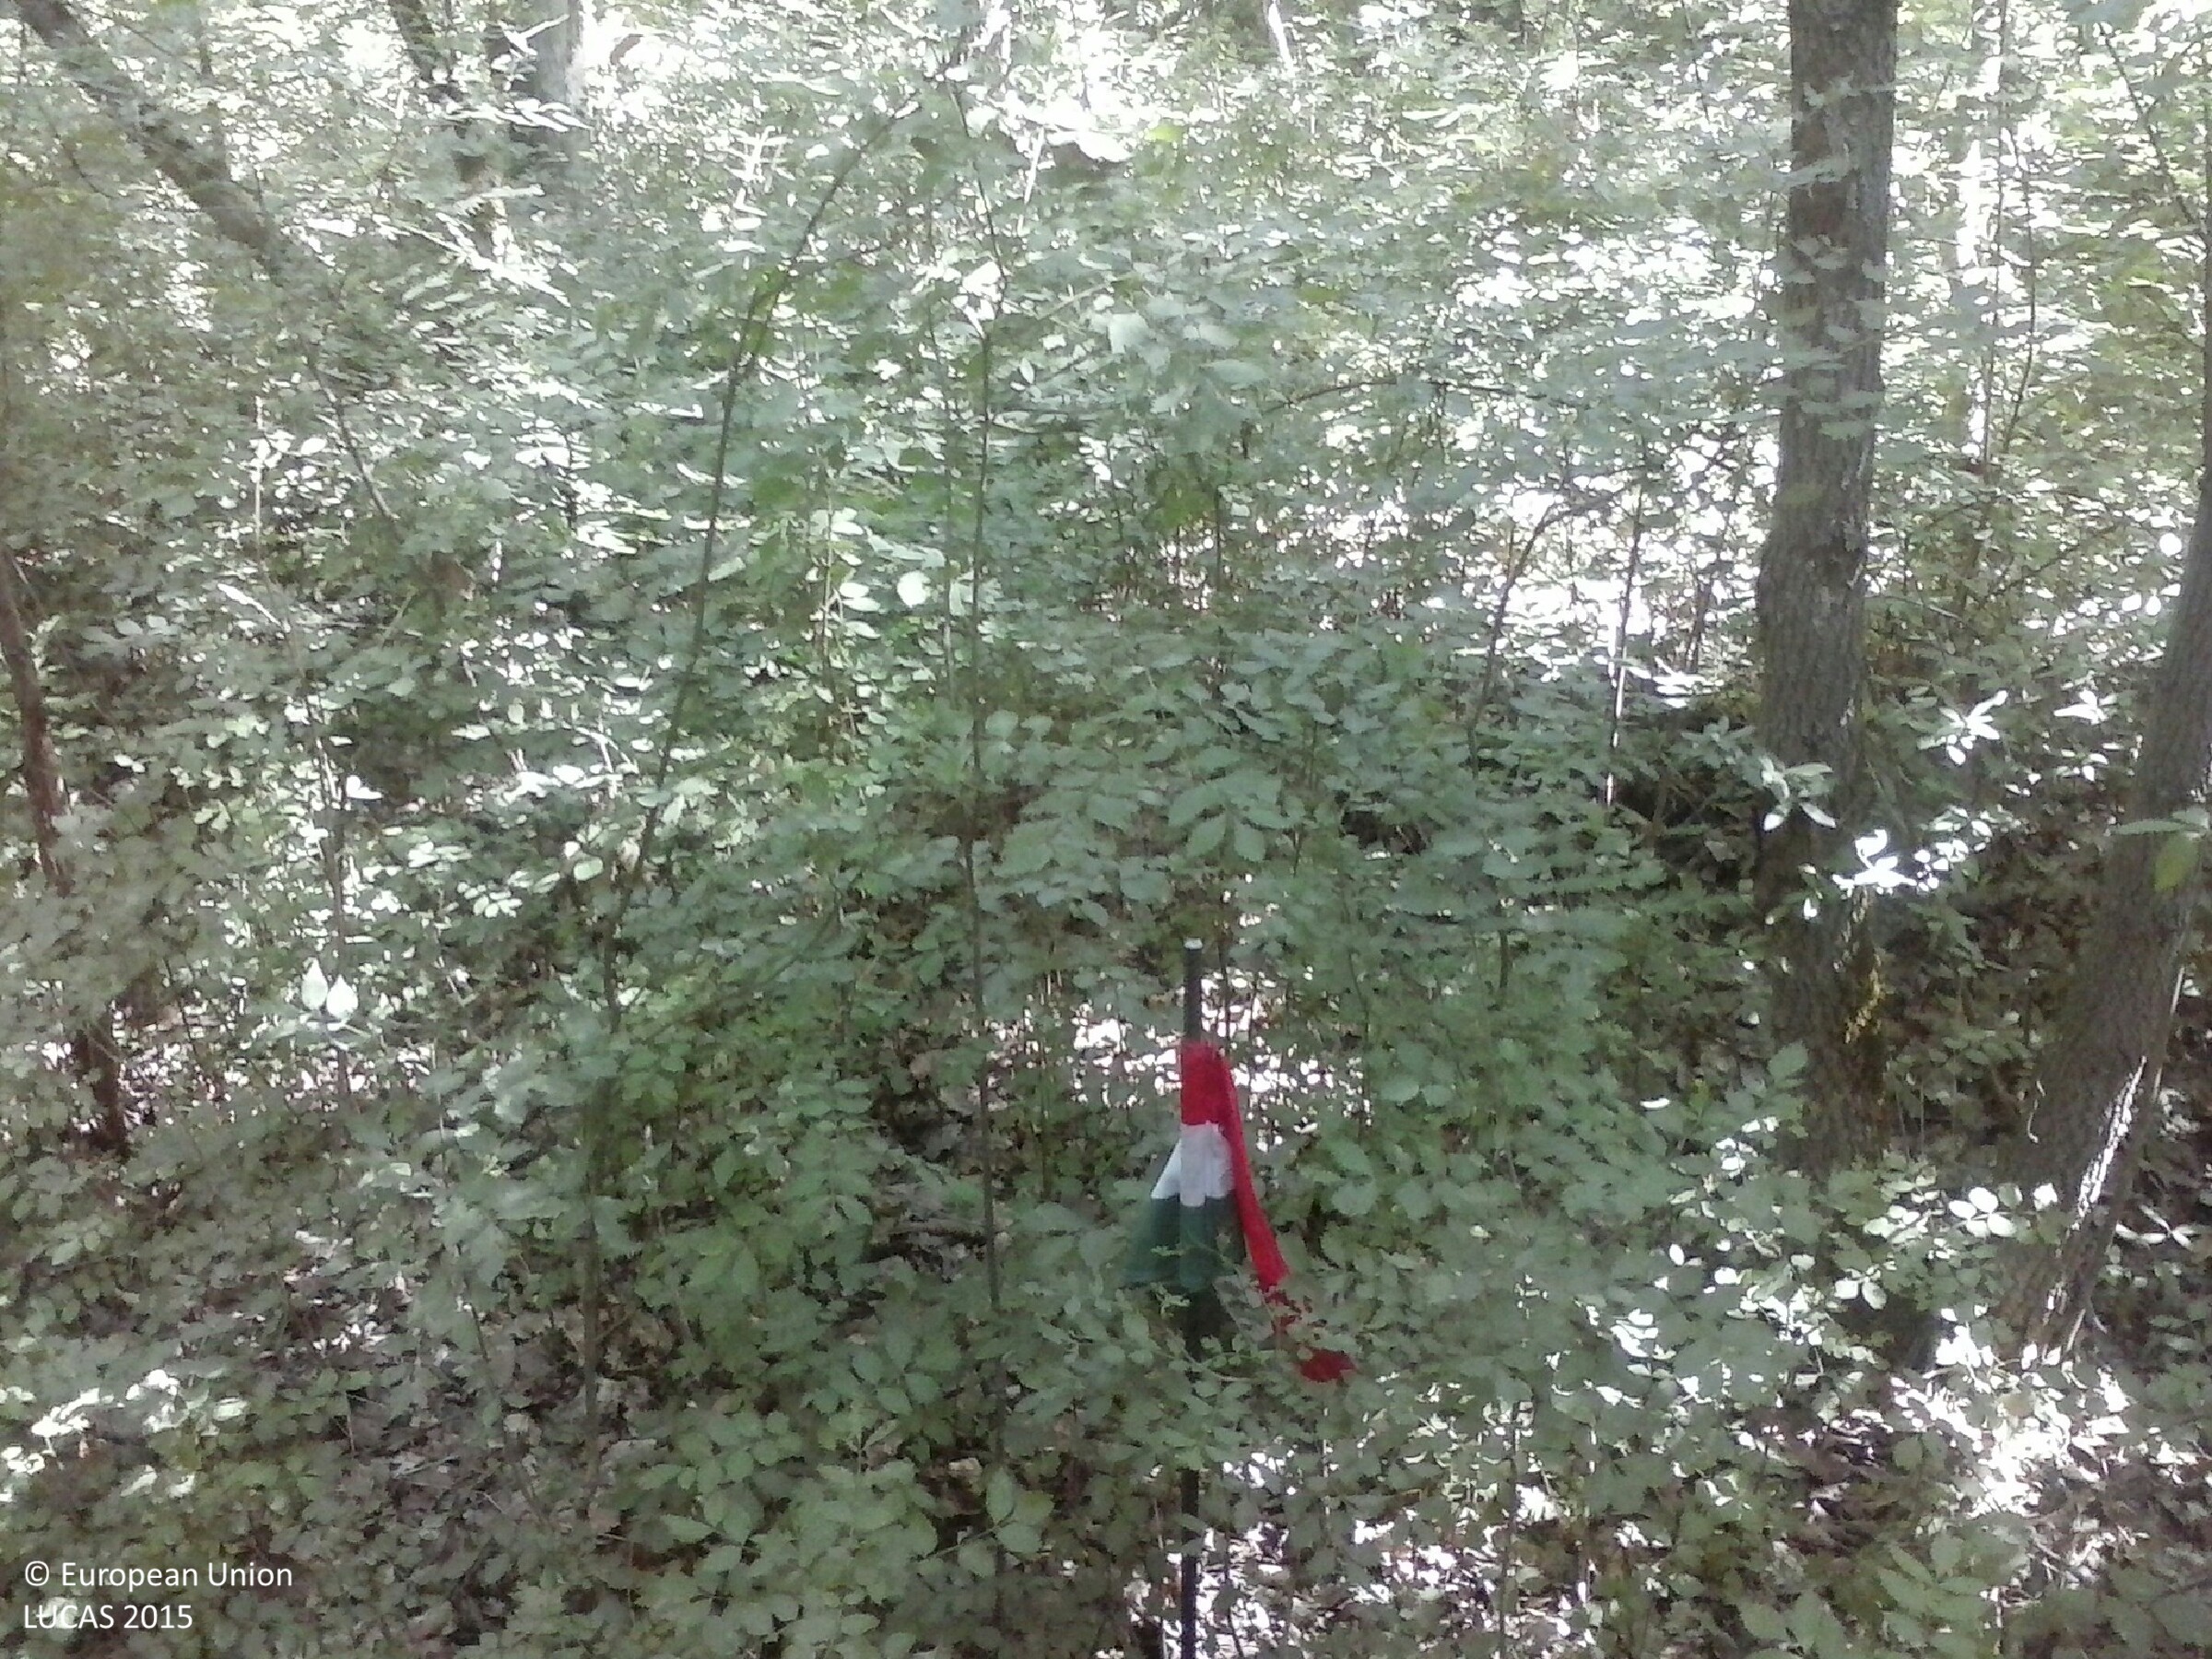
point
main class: Woodland
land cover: Broadleaved woodland
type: exotic forest
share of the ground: > 75 %
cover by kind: broadleaved forest trees 75 %, shrubs 25 %
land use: Forestry
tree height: > 5 m
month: July
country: HU
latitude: 46.5361
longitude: 20.3652
